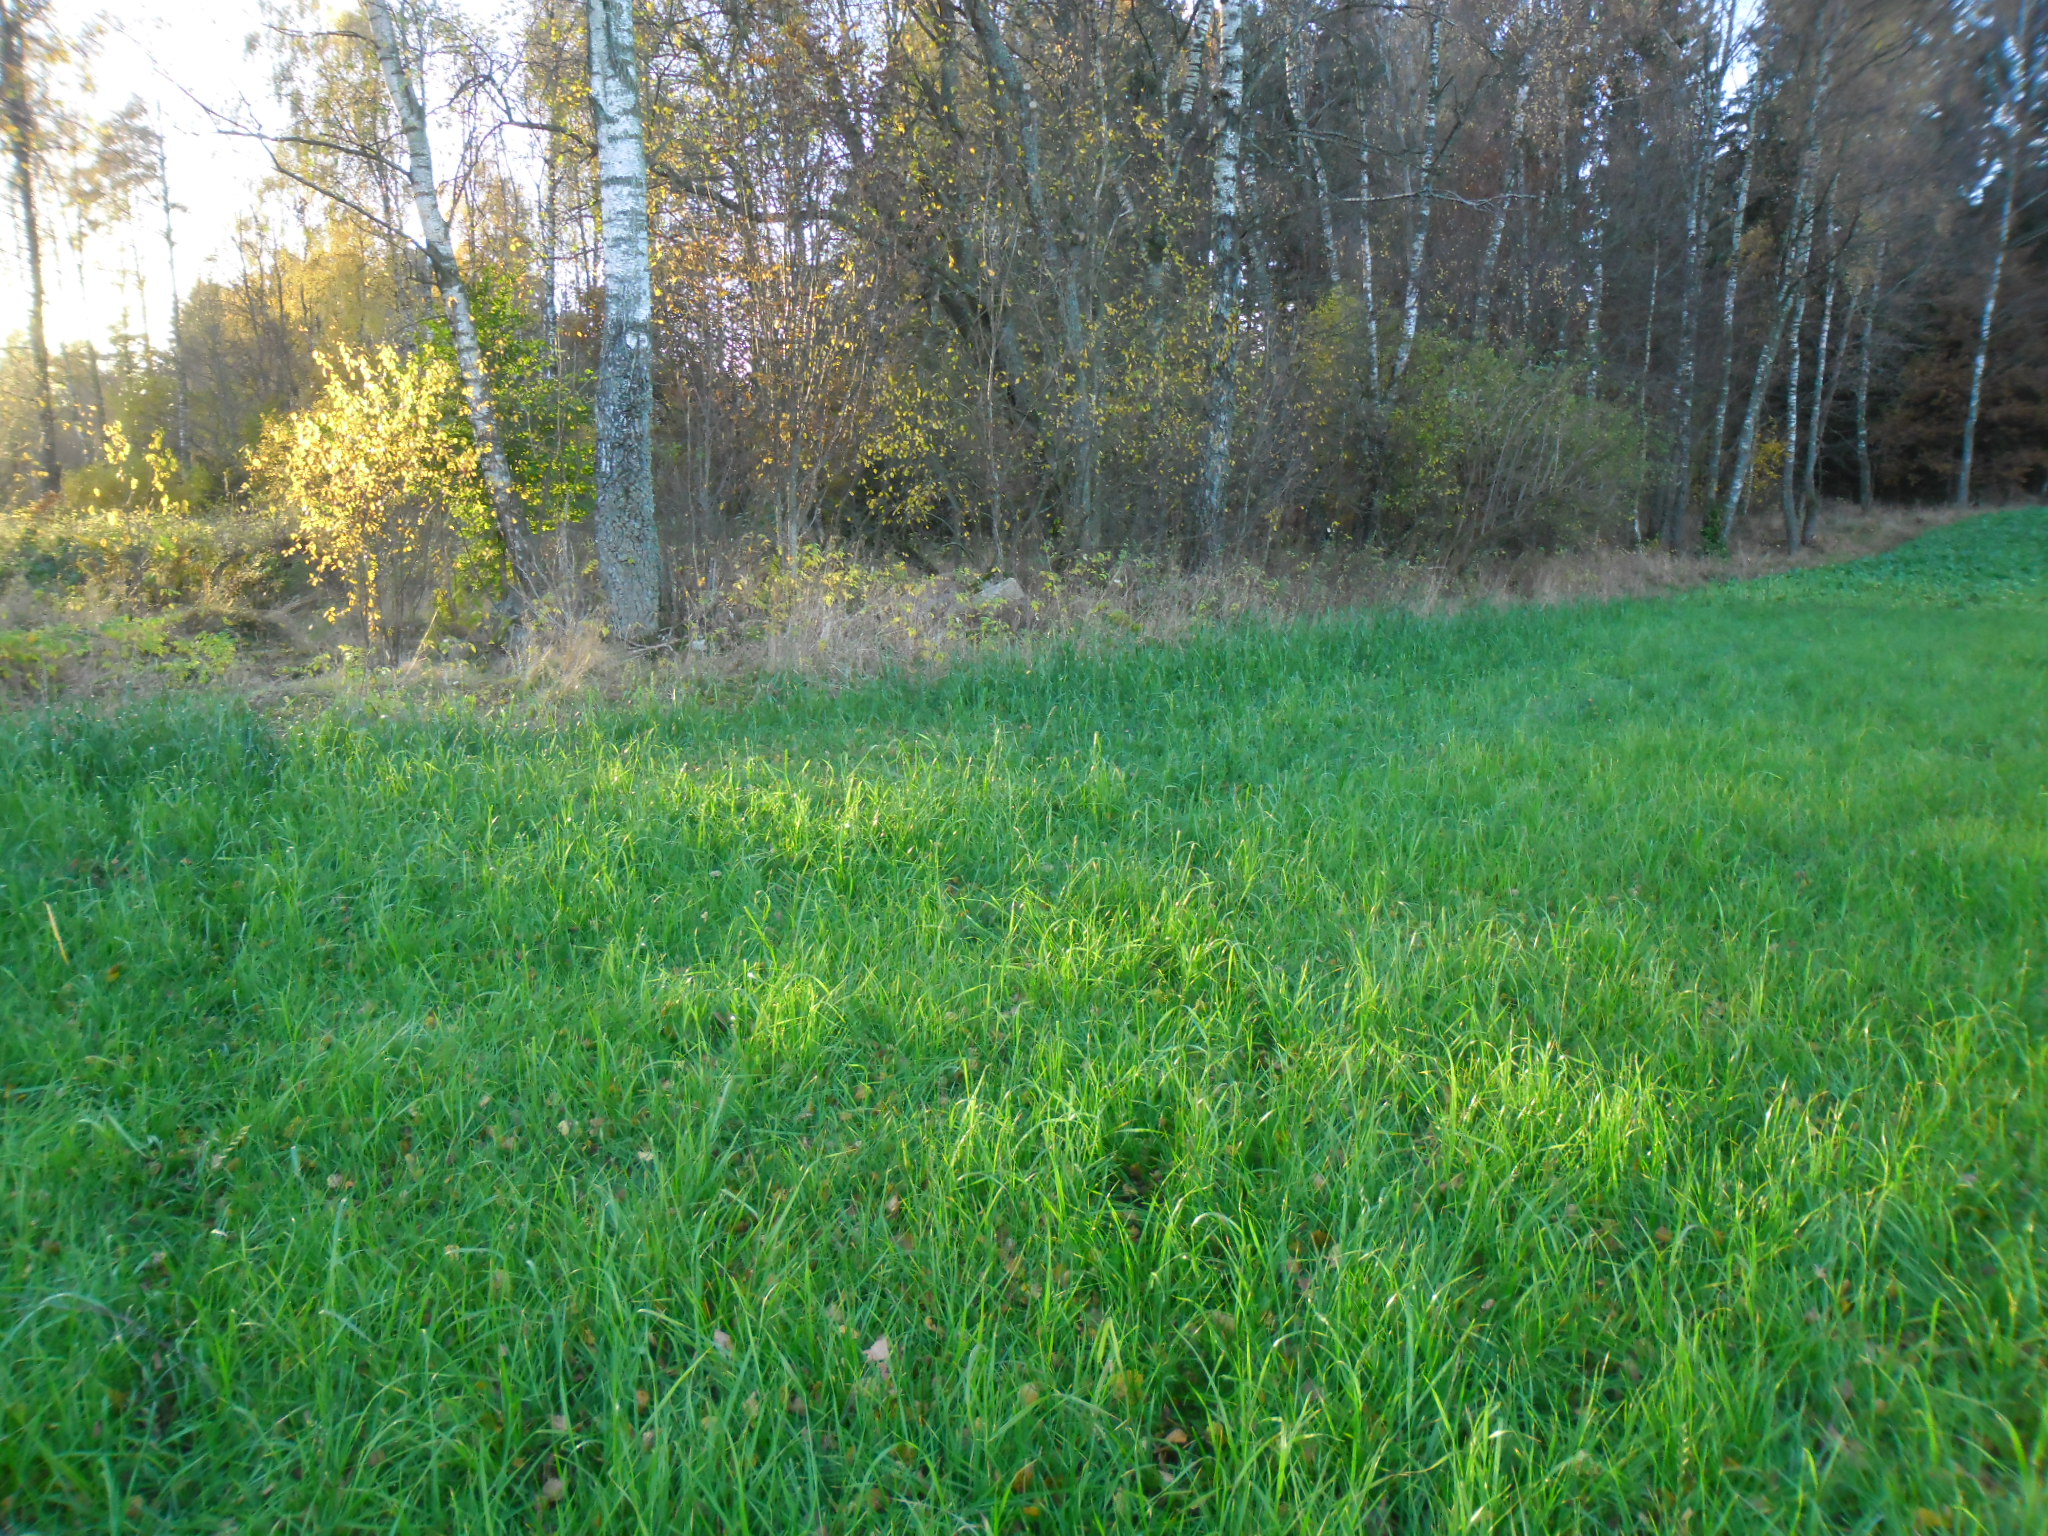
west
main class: Grassland
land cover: Grassland without tree/shrub cover
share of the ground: > 75 %
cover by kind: herbaceous plants 100 %
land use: Agriculture (excluding fallow land and kitchen gardens)
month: October
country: SE
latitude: 56.2059
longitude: 13.7213
